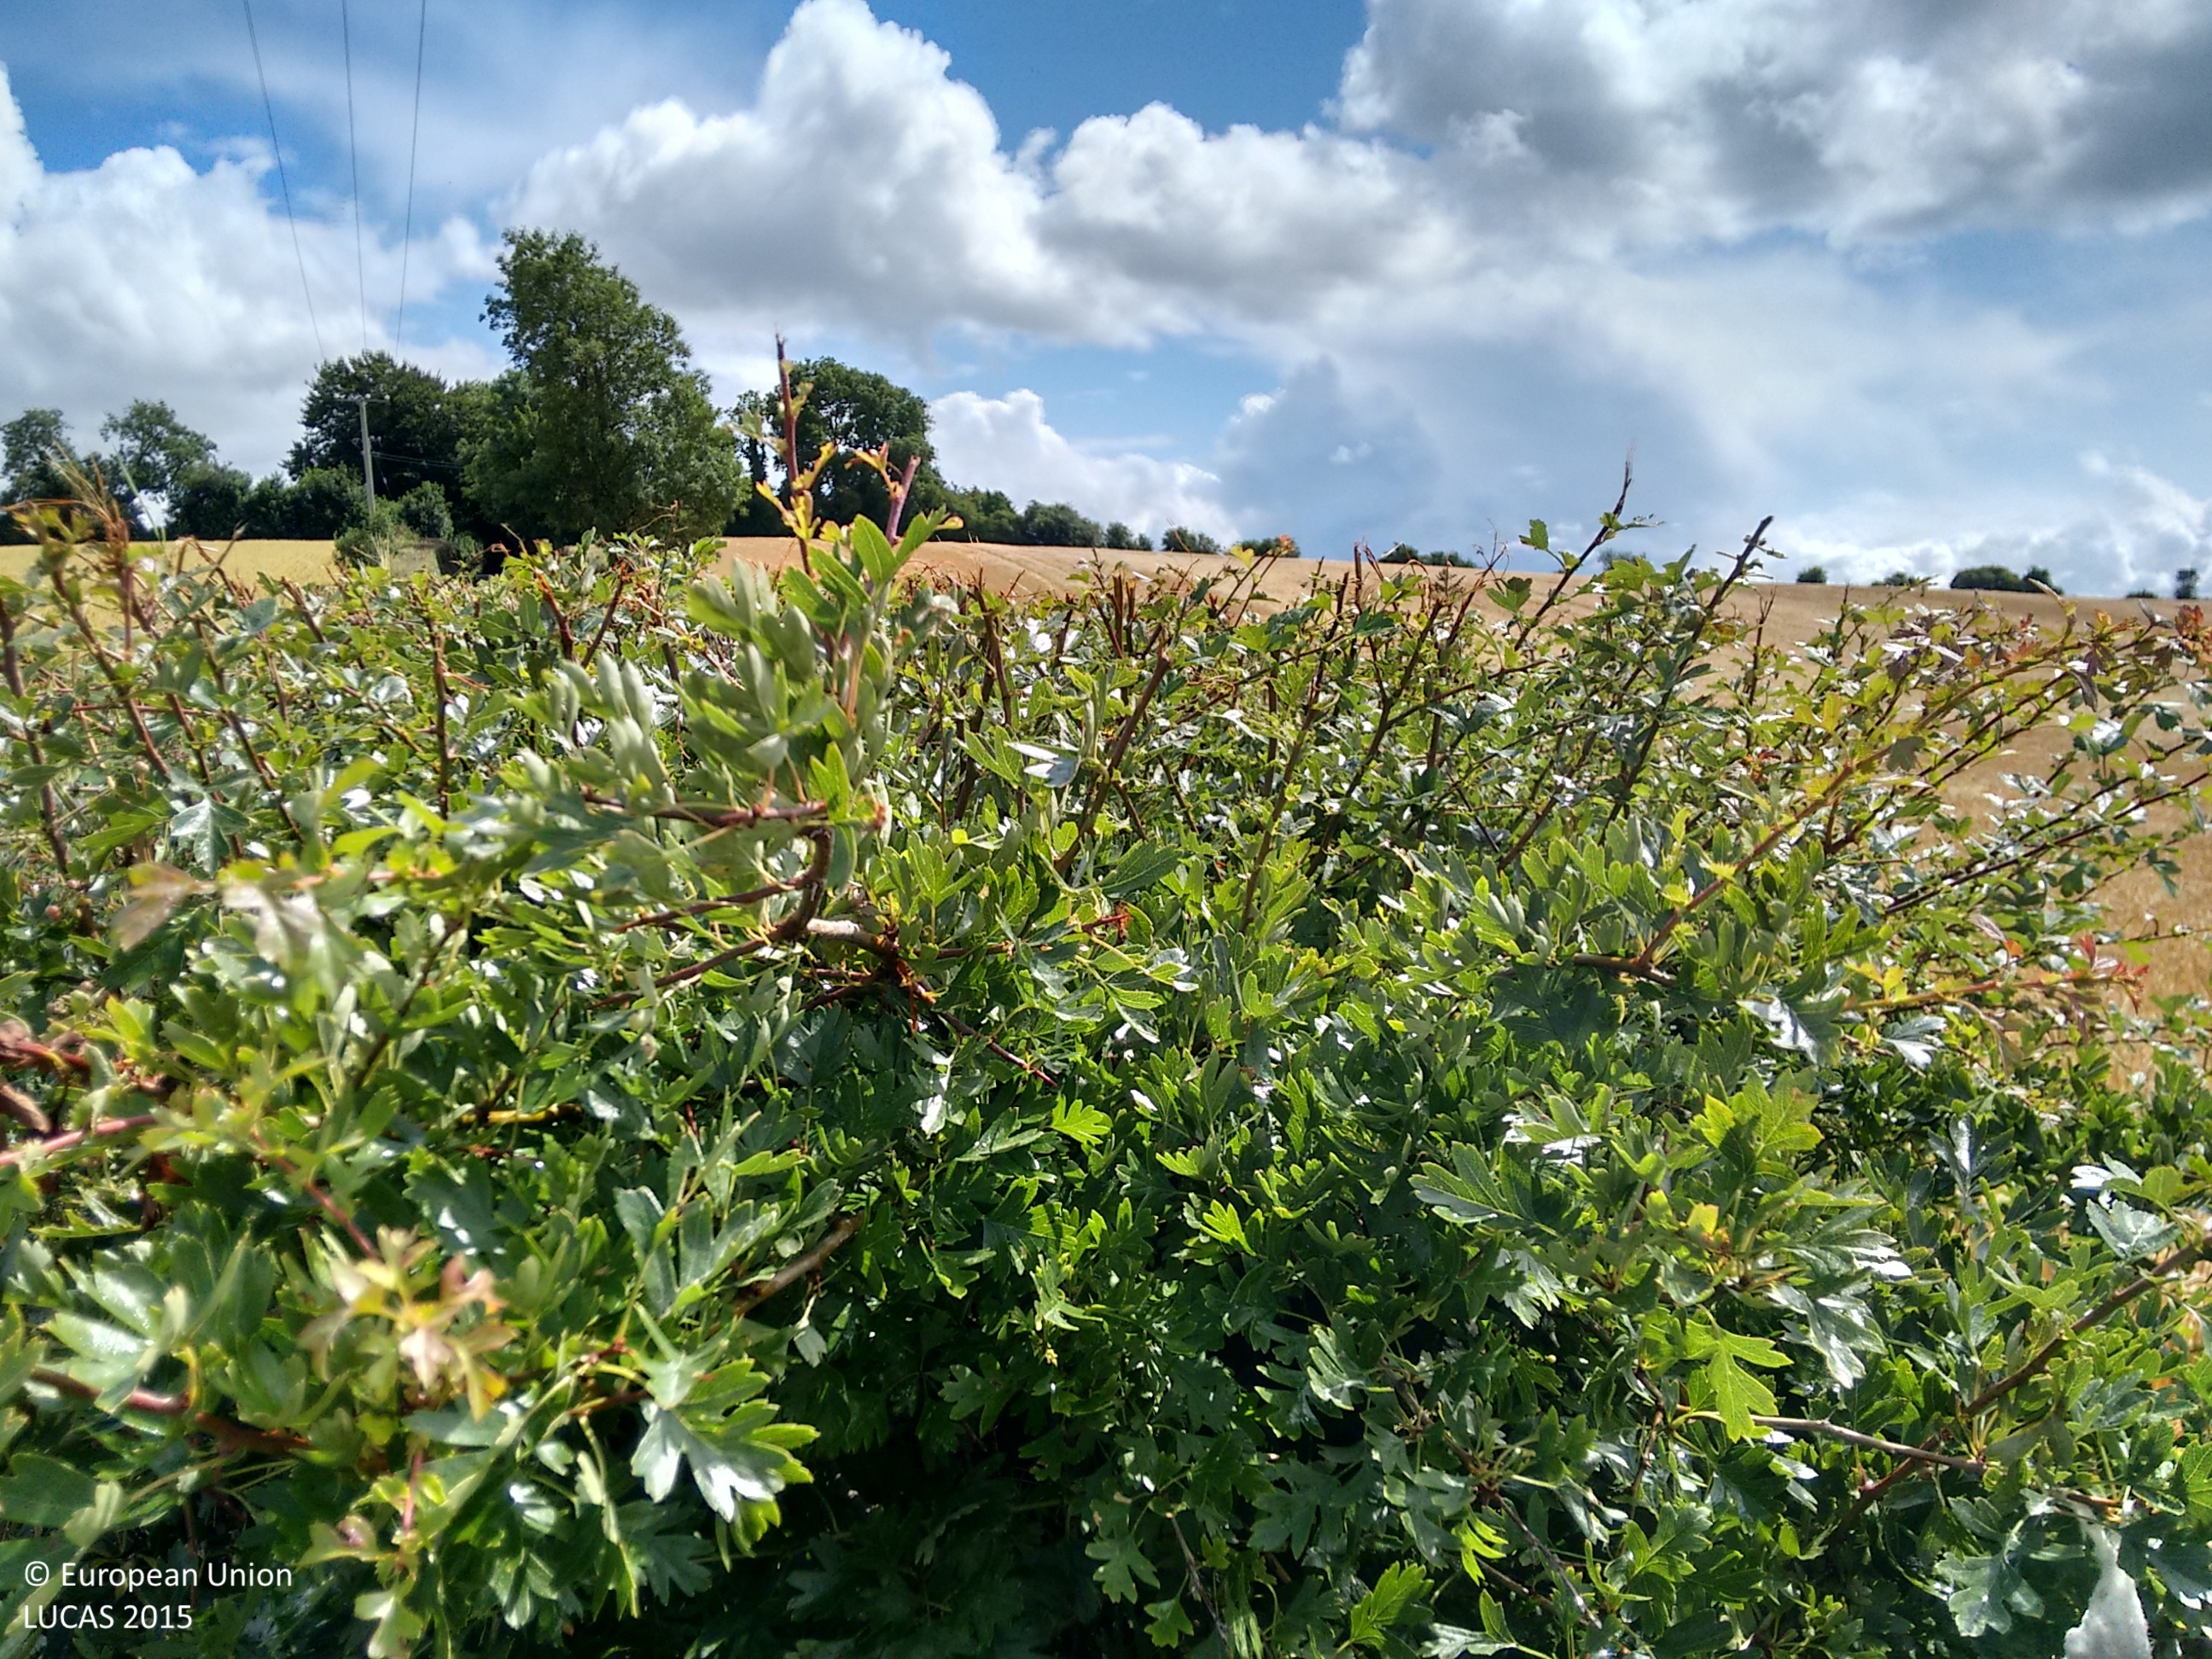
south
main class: Cropland
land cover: Barley
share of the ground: > 75 %
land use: Agriculture (excluding fallow land and kitchen gardens)
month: July
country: IE
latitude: 52.7917
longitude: -6.7588
